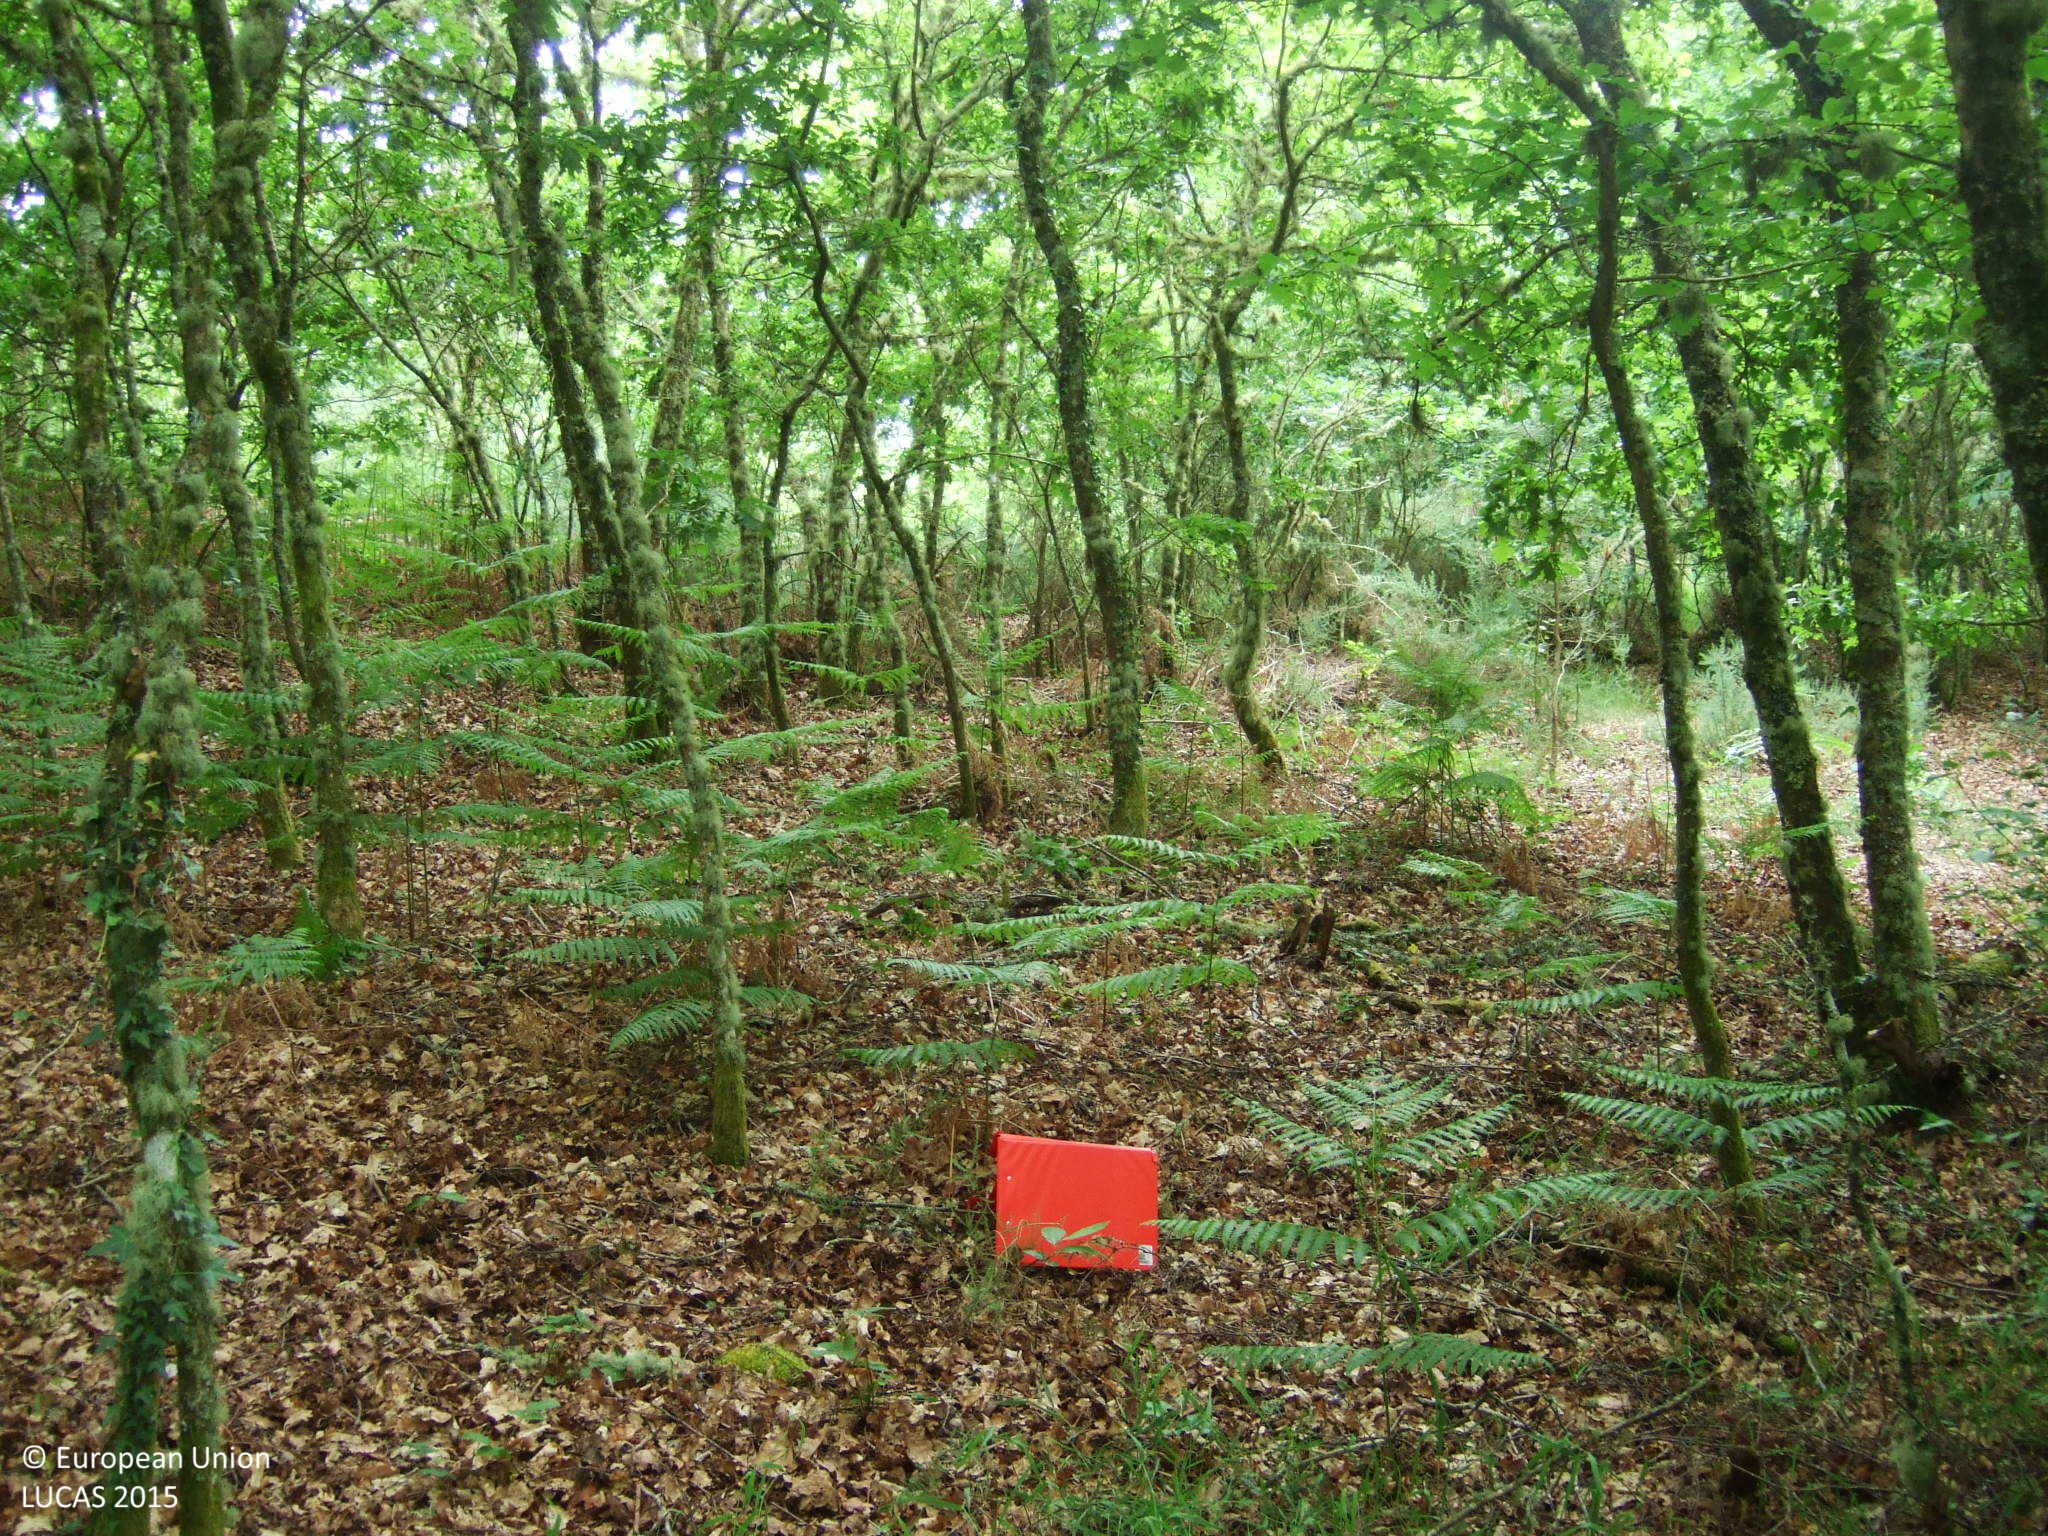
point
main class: Woodland
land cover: Broadleaved woodland
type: acidophilous oak and oak-birch forest
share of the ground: 50 - 75 %
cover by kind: broadleaved forest trees 70 %, shrubs 15 %, herbaceous plants 15 %
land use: Forestry
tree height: > 5 m
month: June
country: ES
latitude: 43.3726
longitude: -7.7733
